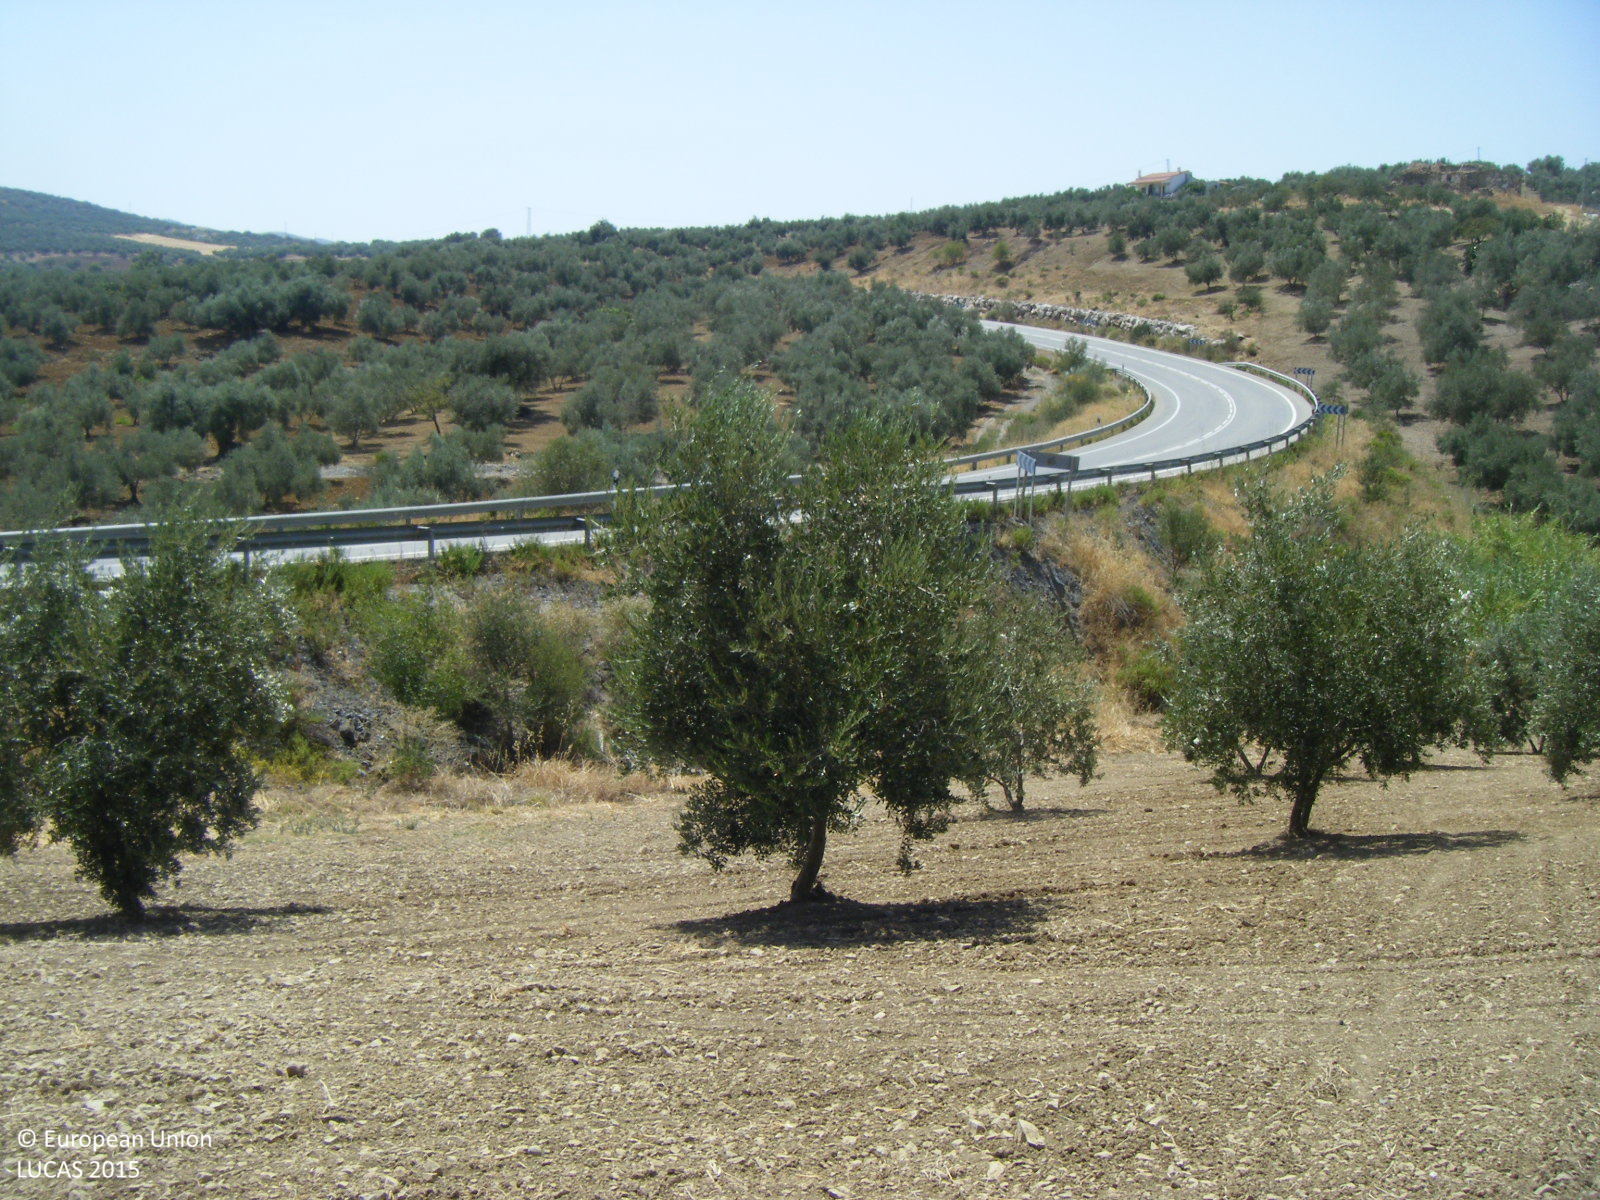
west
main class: Cropland
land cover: Olive groves
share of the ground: 10 - 25 %
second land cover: Other bare soil
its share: > 75 %
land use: Agriculture (excluding fallow land and kitchen gardens)
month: July
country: ES
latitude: 36.9243
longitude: -4.2598
